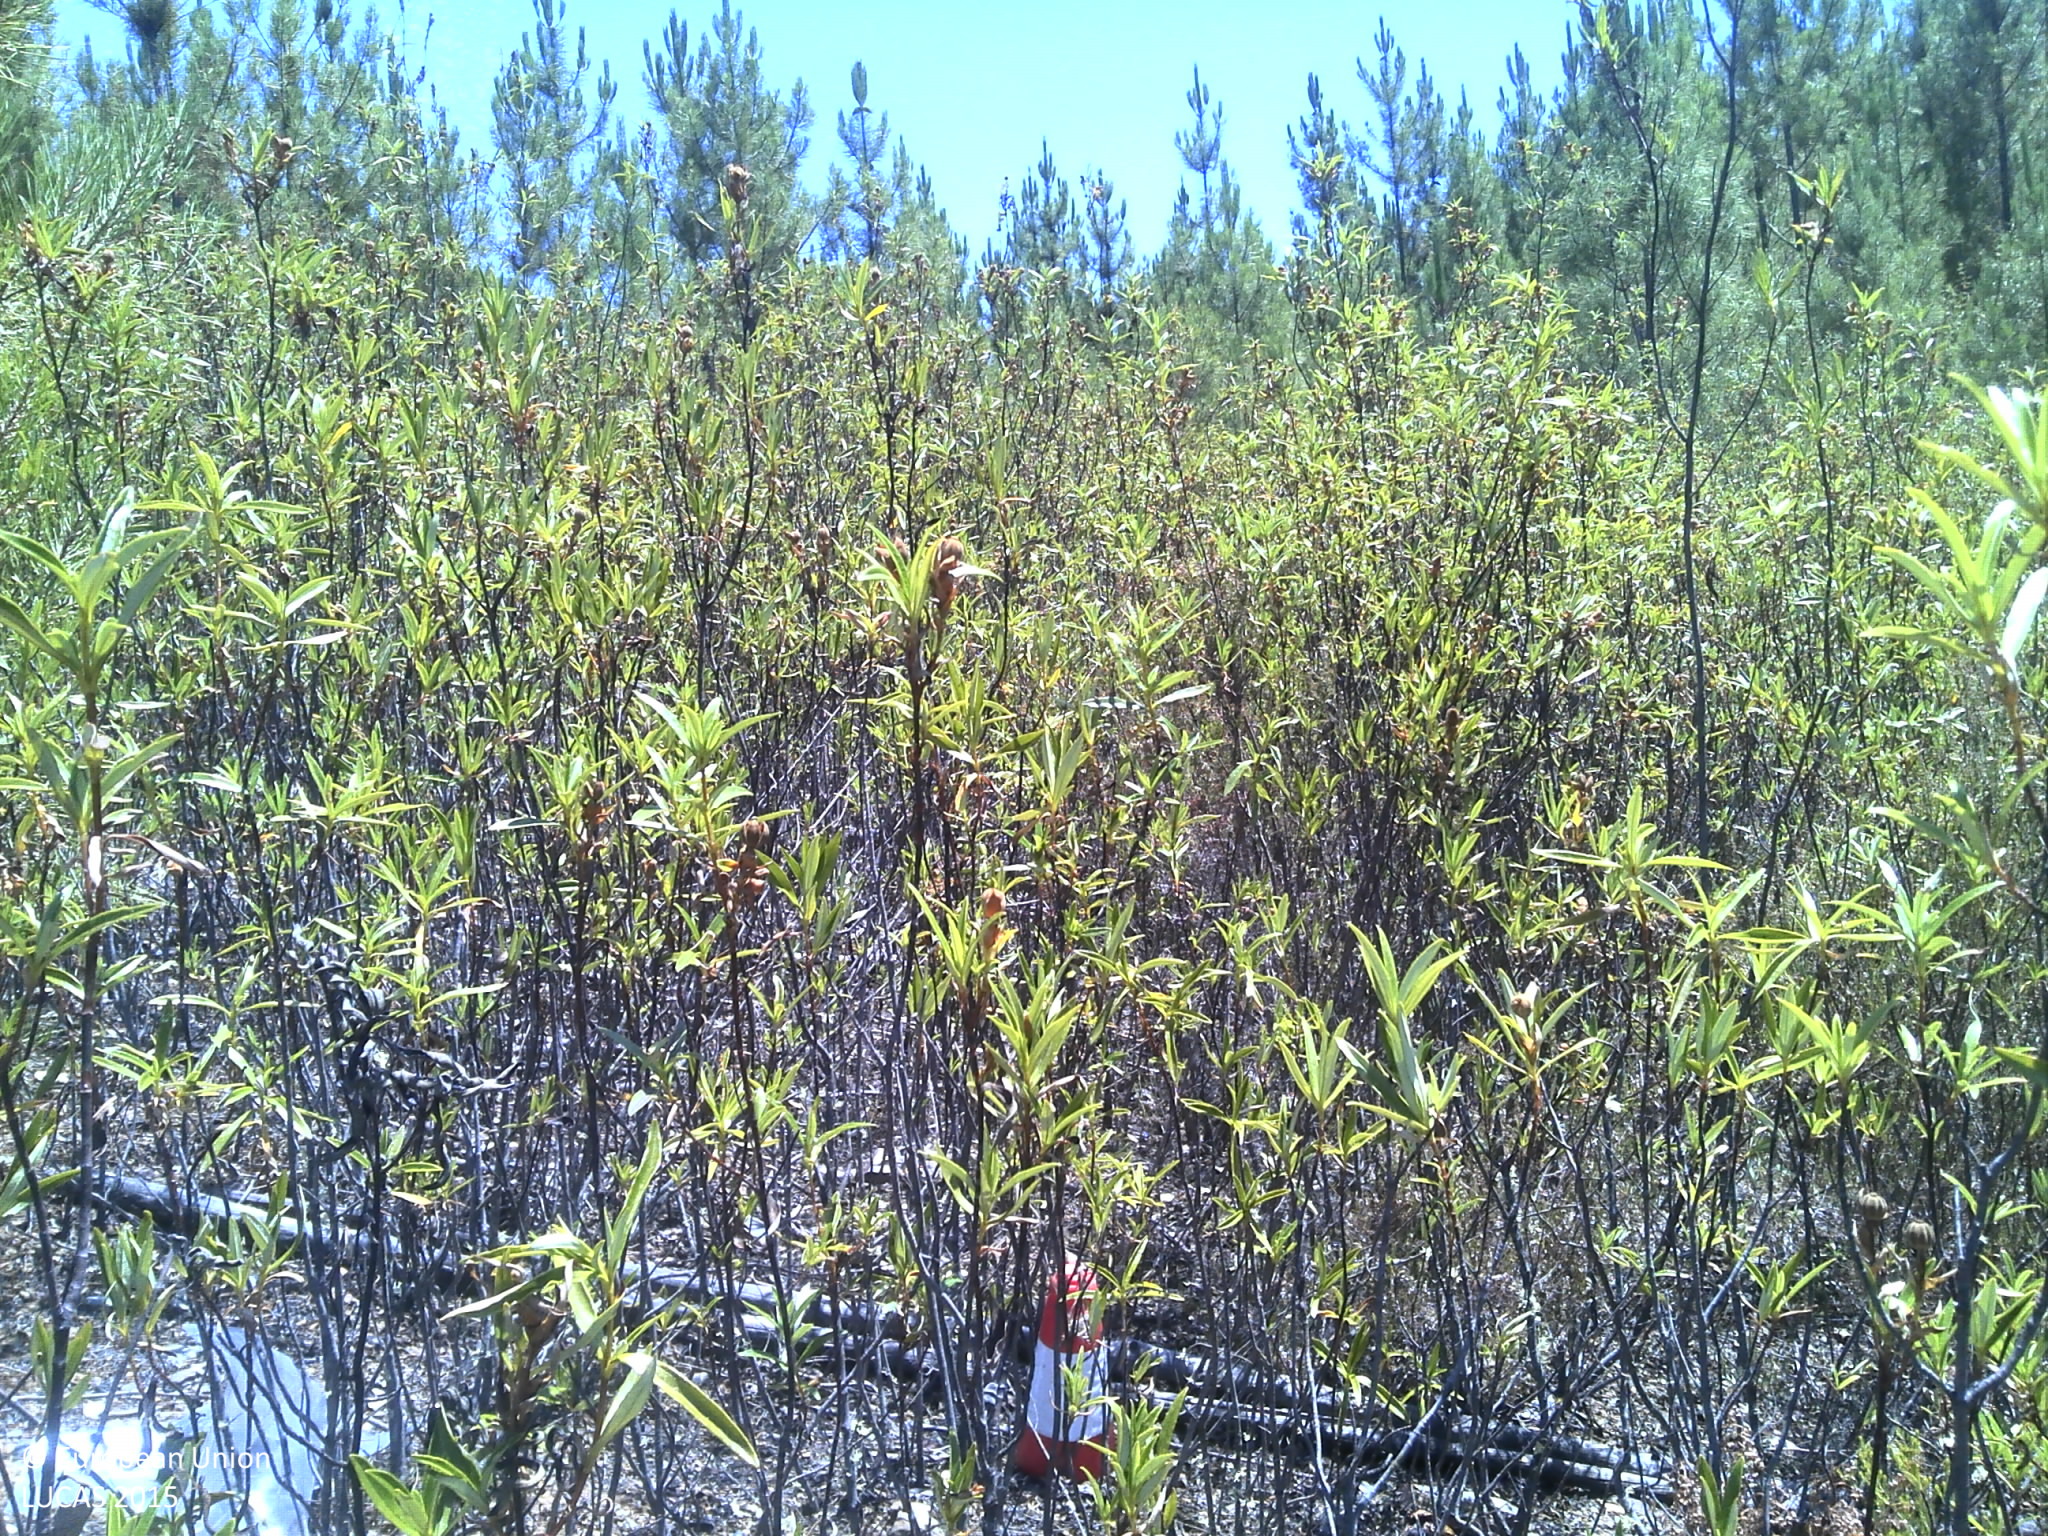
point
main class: Woodland
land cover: Pine dominated coniferous woodland
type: coniferous forest of the mediterranean region
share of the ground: 10 - 25 %
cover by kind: shrubs 75 %, coniferous forest trees 15 %, unconsolidated bare surface 10 %
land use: Forestry
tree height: < 5 m
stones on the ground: 10 - 25 %
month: July
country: PT
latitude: 39.9413
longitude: -7.6722
